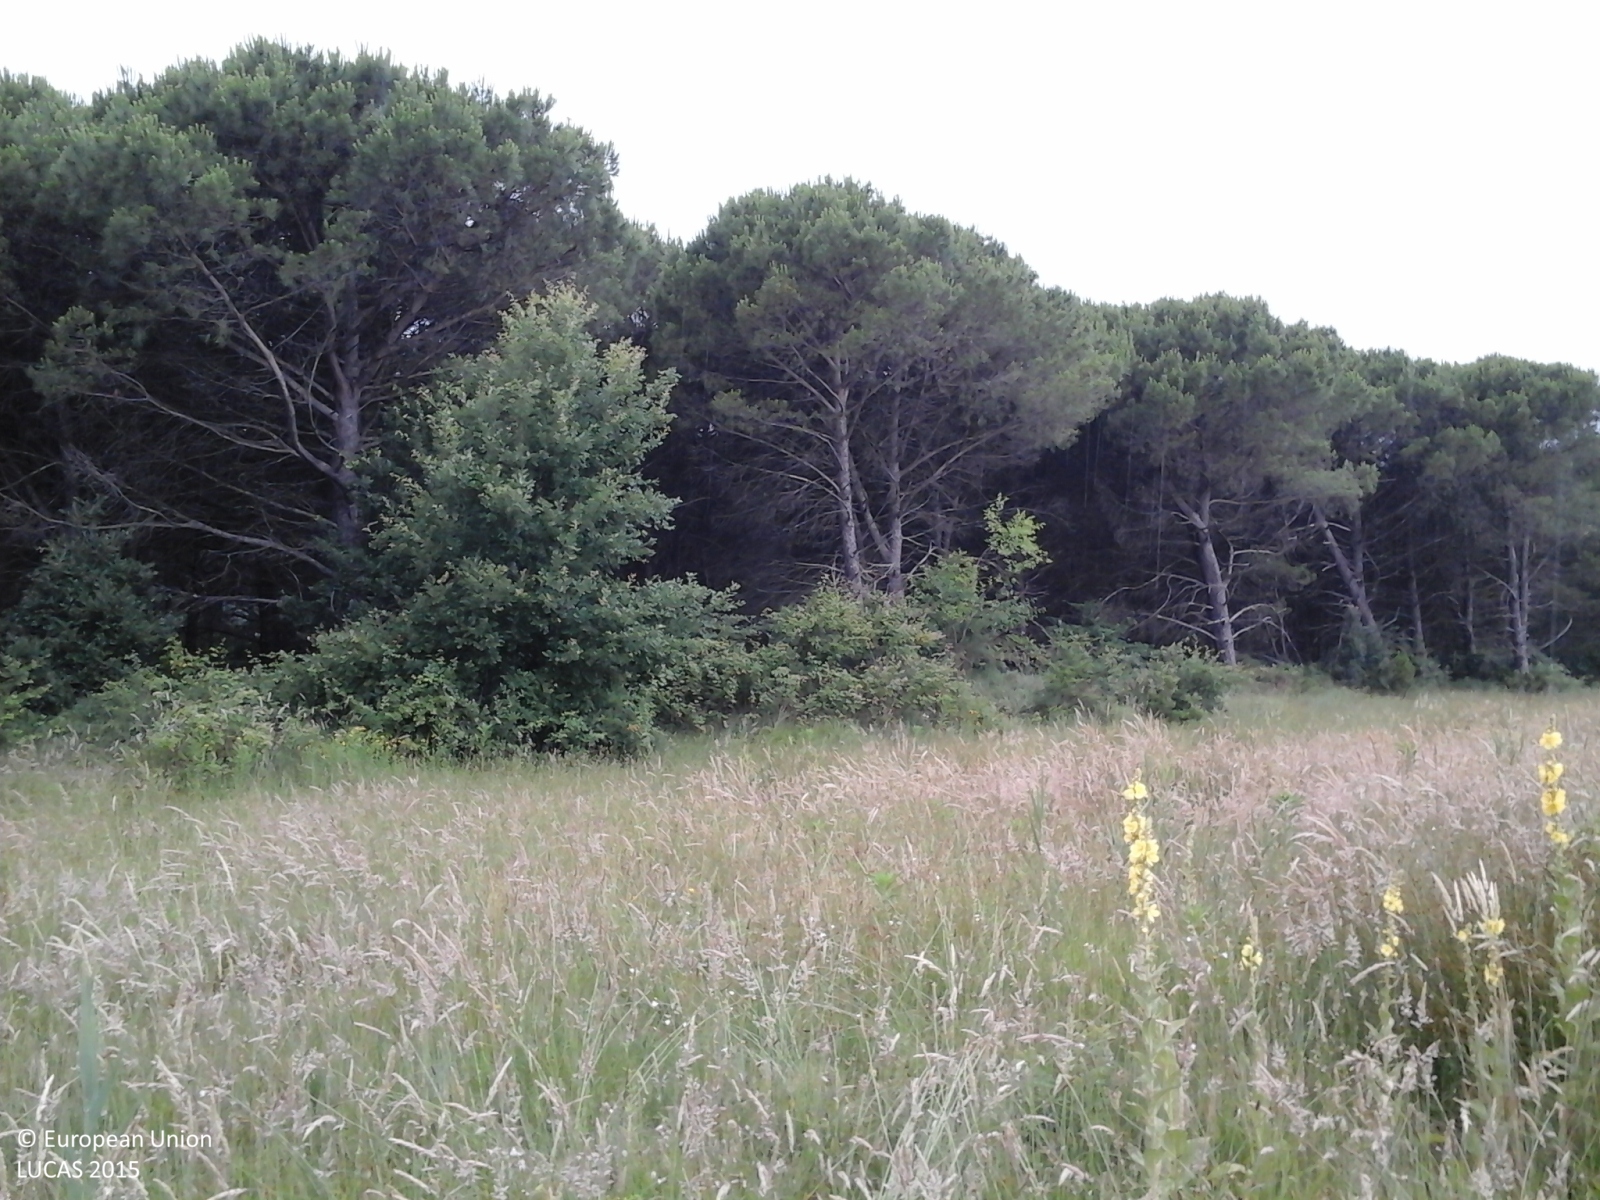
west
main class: Grassland
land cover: Grassland without tree/shrub cover
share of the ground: > 75 %
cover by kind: herbaceous plants 100 %
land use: Agriculture (excluding fallow land and kitchen gardens)
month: June
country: IT
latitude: 44.5968
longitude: 12.2505
